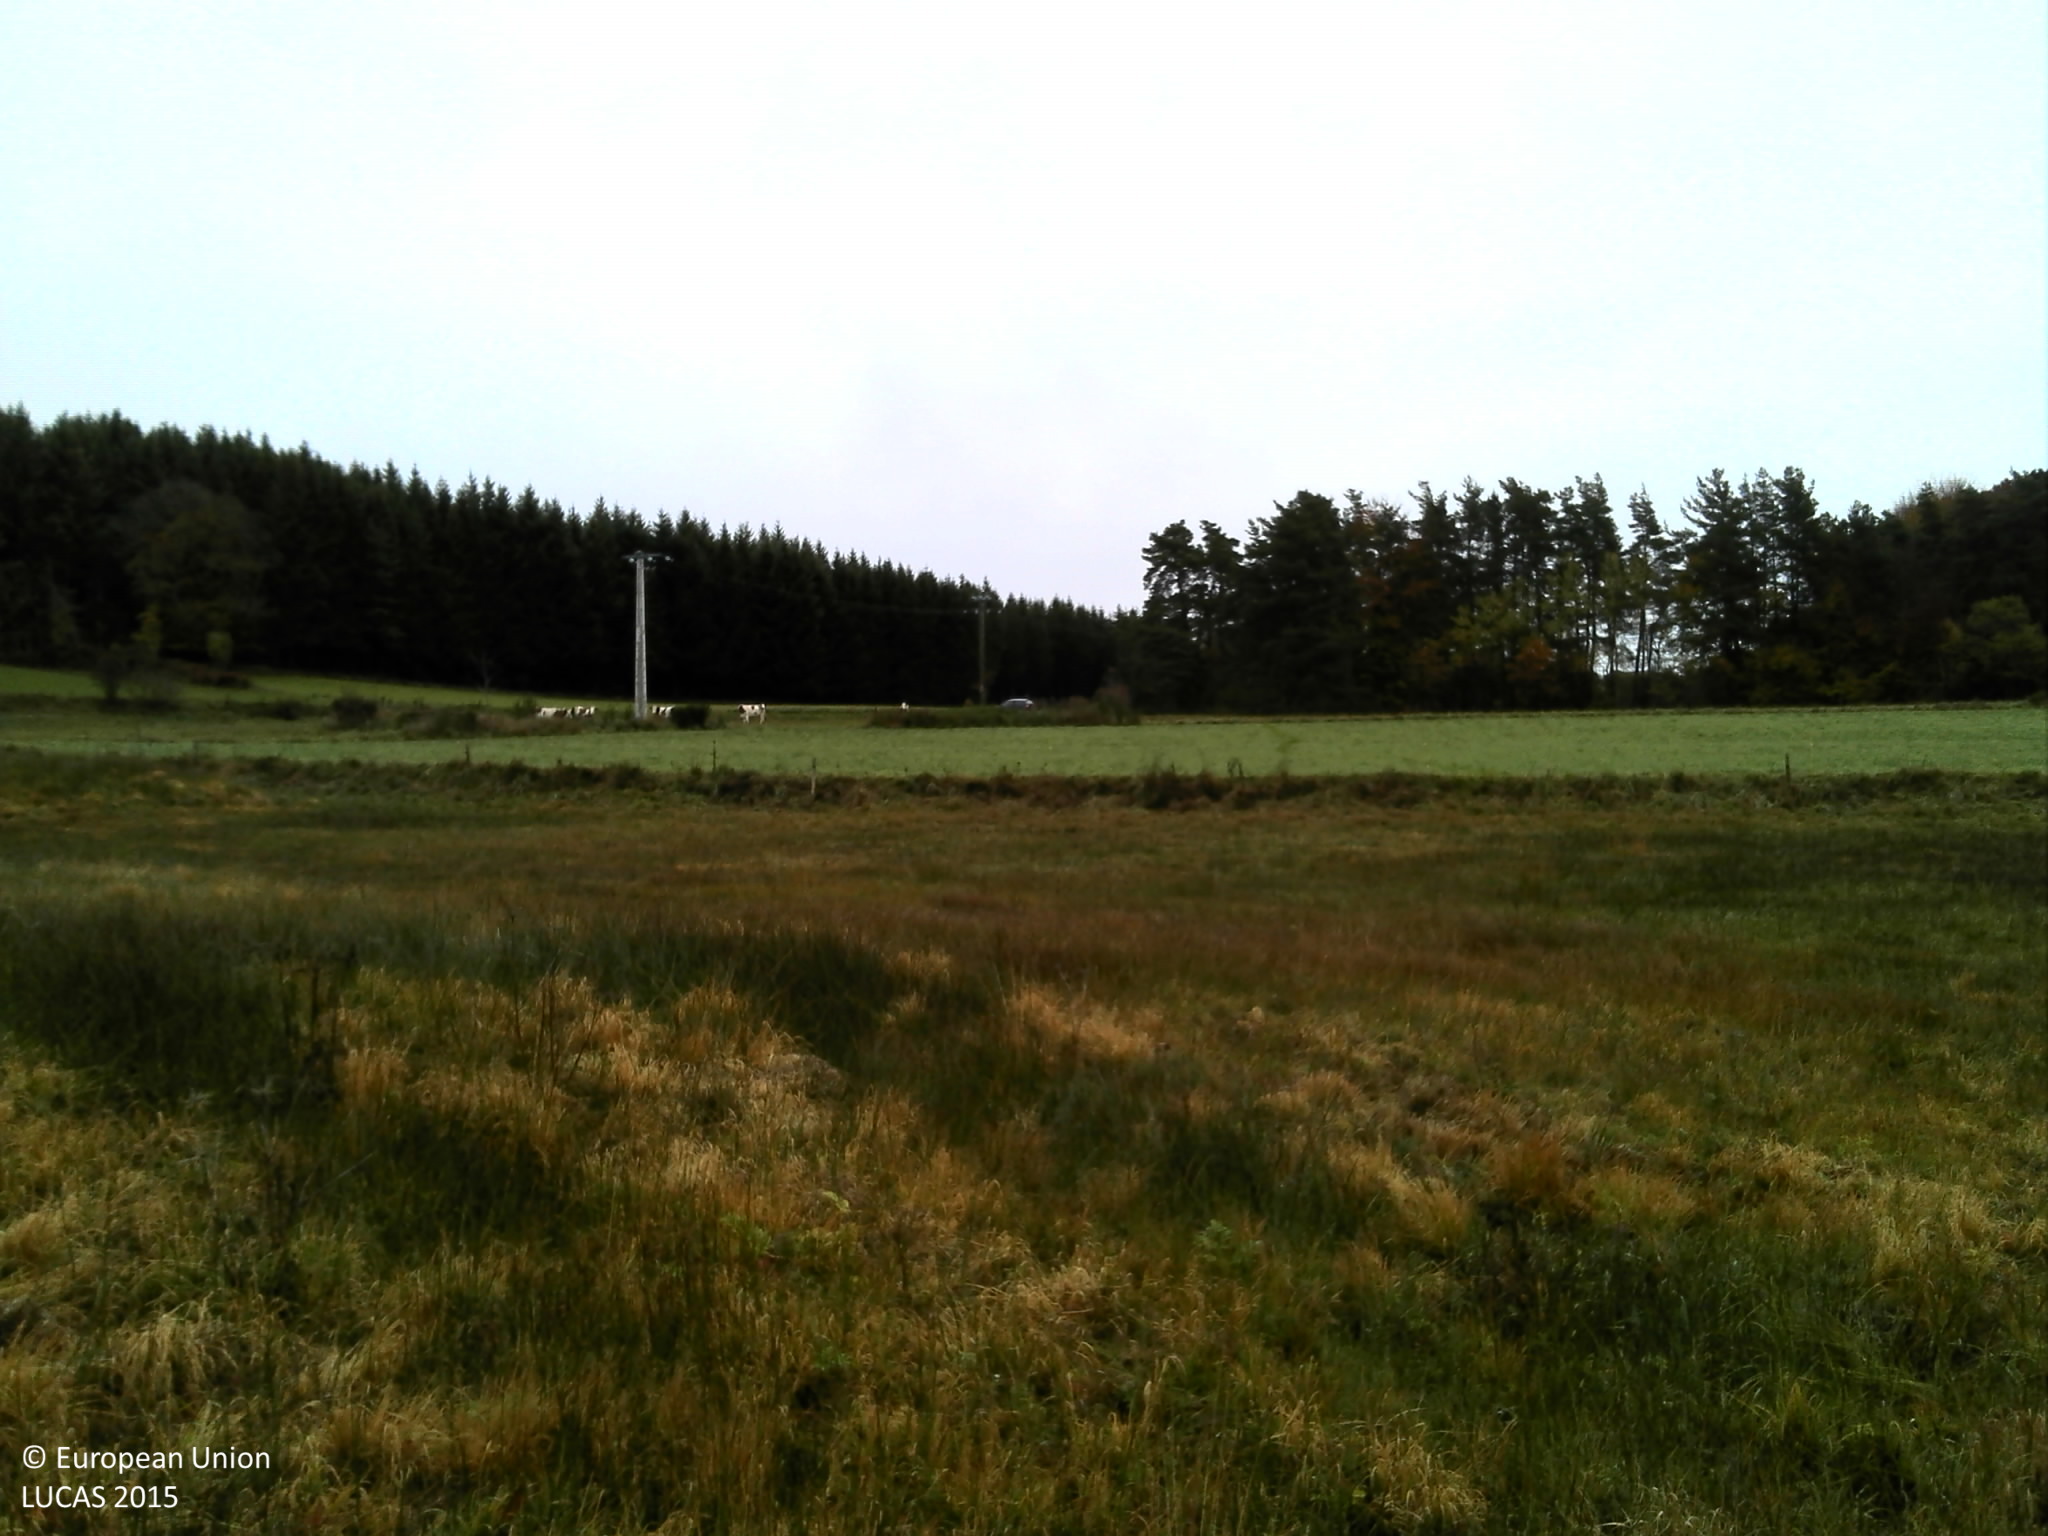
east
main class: Grassland
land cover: Grassland without tree/shrub cover
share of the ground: > 75 %
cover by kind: herbaceous plants 100 %
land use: Agriculture (excluding fallow land and kitchen gardens)
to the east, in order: Grassland without tree/shrub cover; Fences; Temporary grasslands; Grassland without tree/shrub cover; Paved roads, cycling and walking lanes; Grass margins; Ditches and canals; Pine dominated mixed woodland; Grassland without tree/shrub cover
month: October
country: FR
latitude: 45.4143
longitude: 3.8310
